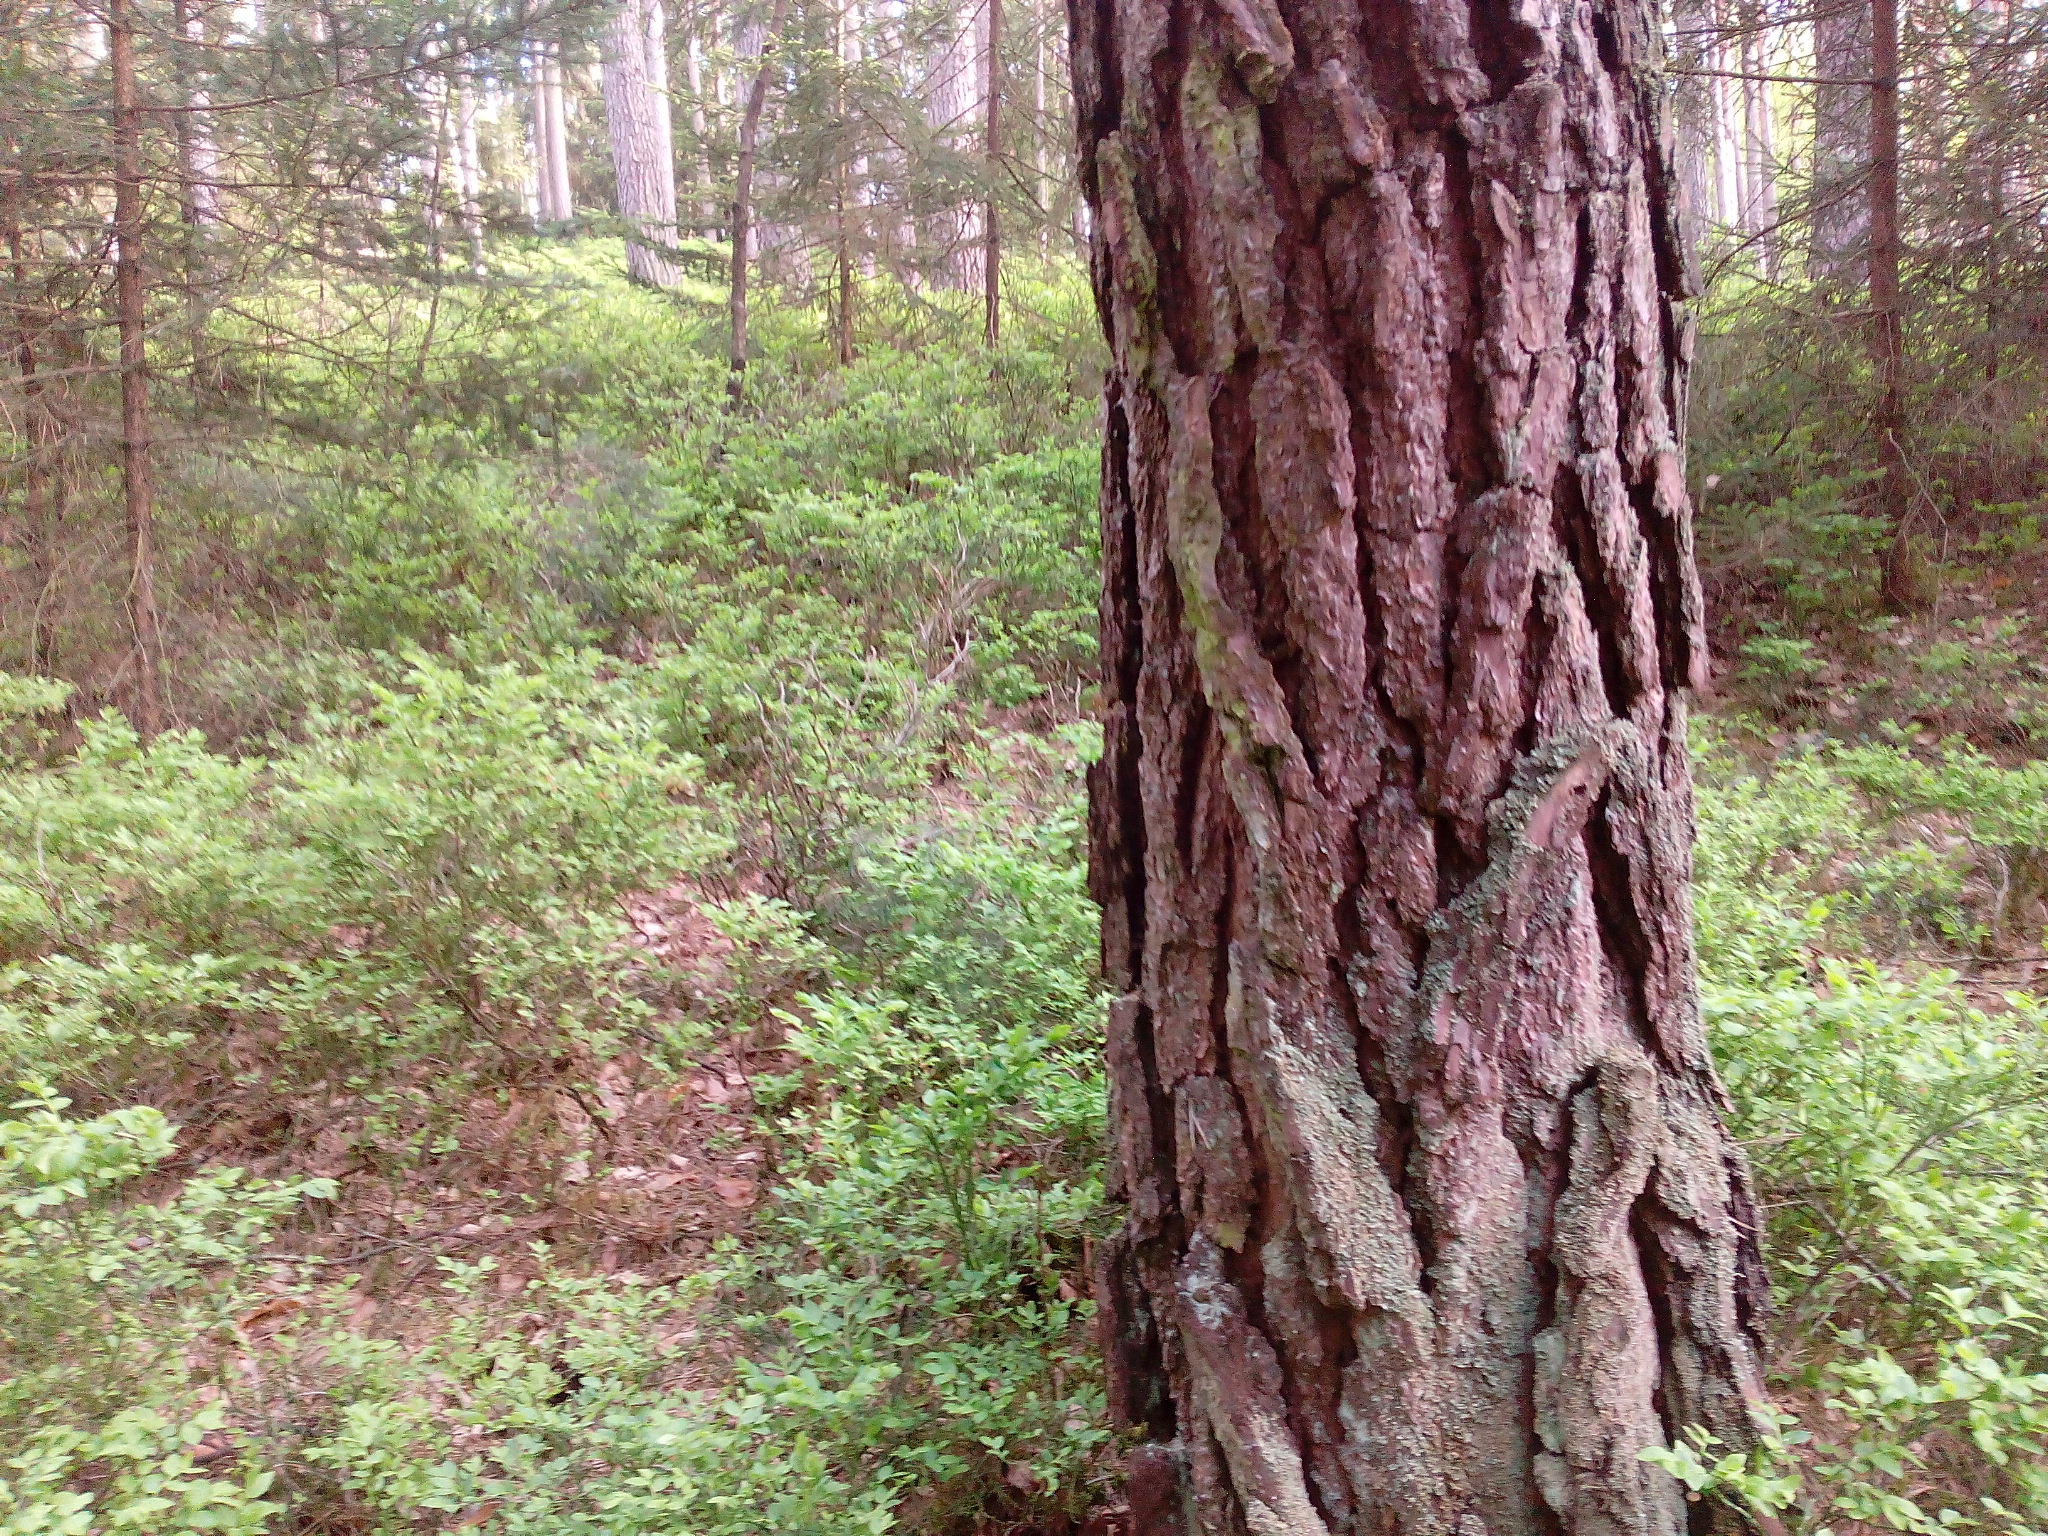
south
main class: Woodland
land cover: Pine dominated coniferous woodland
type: hemiboreal forest and nemoral coniferous forest and mixed broadleaved-coniferous forest
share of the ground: > 75 %
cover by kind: coniferous forest trees 85 %, broadleaved forest trees 10 %, shrubs 5 %
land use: Forestry
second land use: Amenities, museums, leisure
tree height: > 5 m
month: May
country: DE
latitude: 49.9220
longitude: 11.5457
